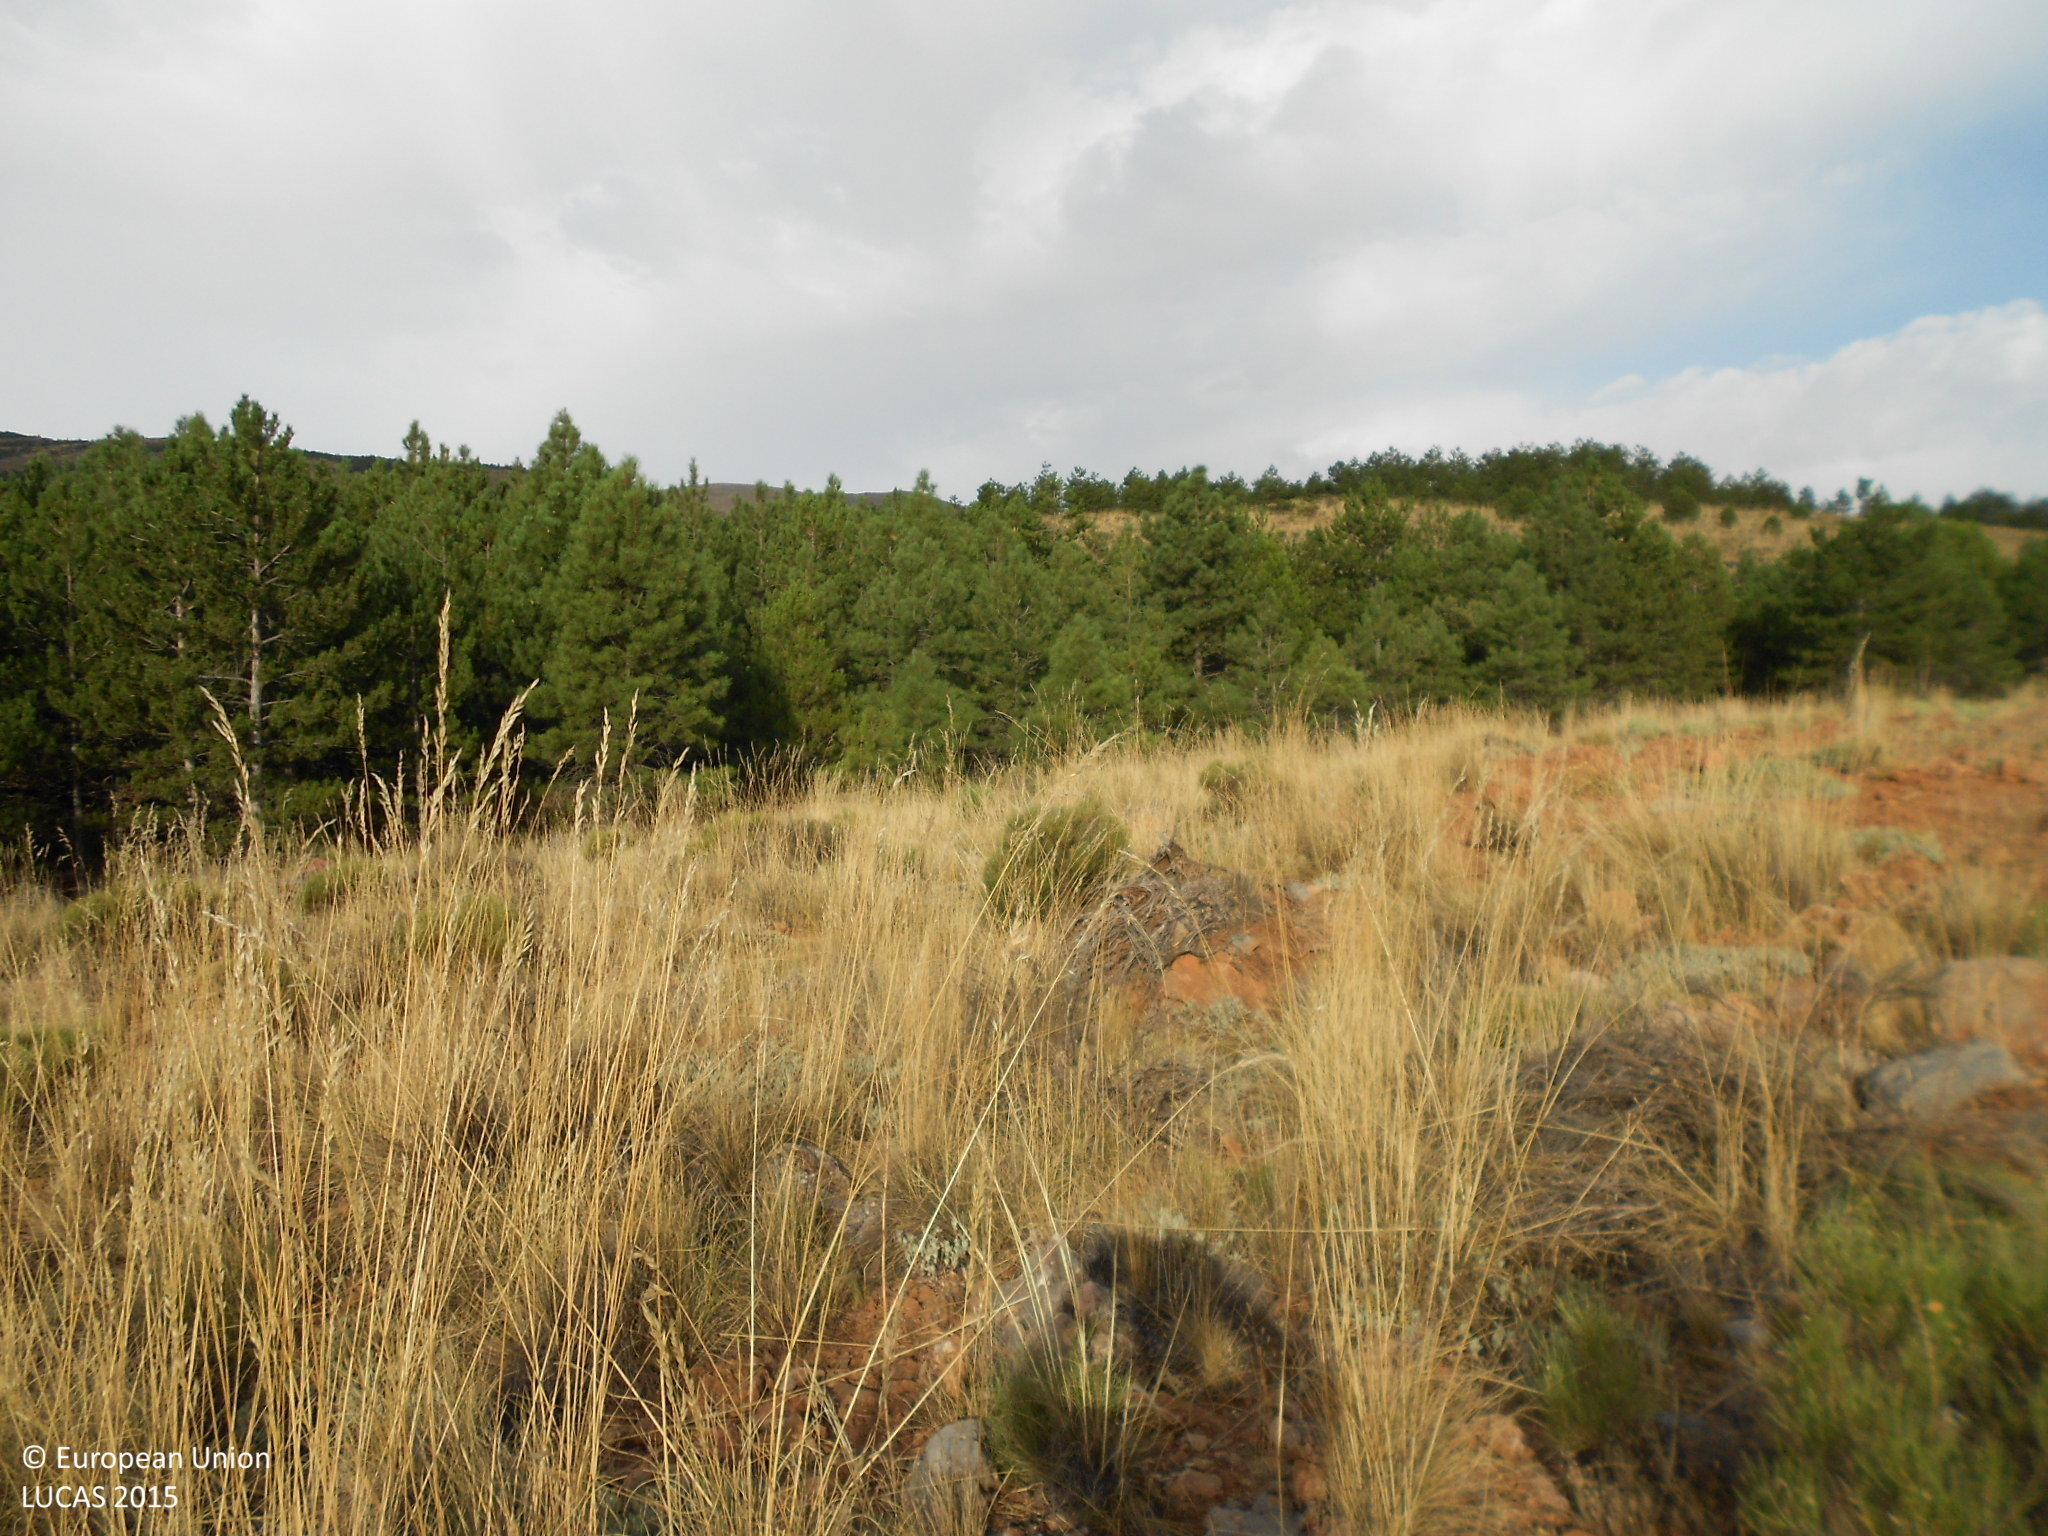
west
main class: Shrubland
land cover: Shrubland without tree cover
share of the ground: 10 - 25 %
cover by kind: herbaceous plants 80 %, shrubs 20 %
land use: Semi-natural and natural areas not in use
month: July
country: ES
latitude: 36.9173
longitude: -2.7860
